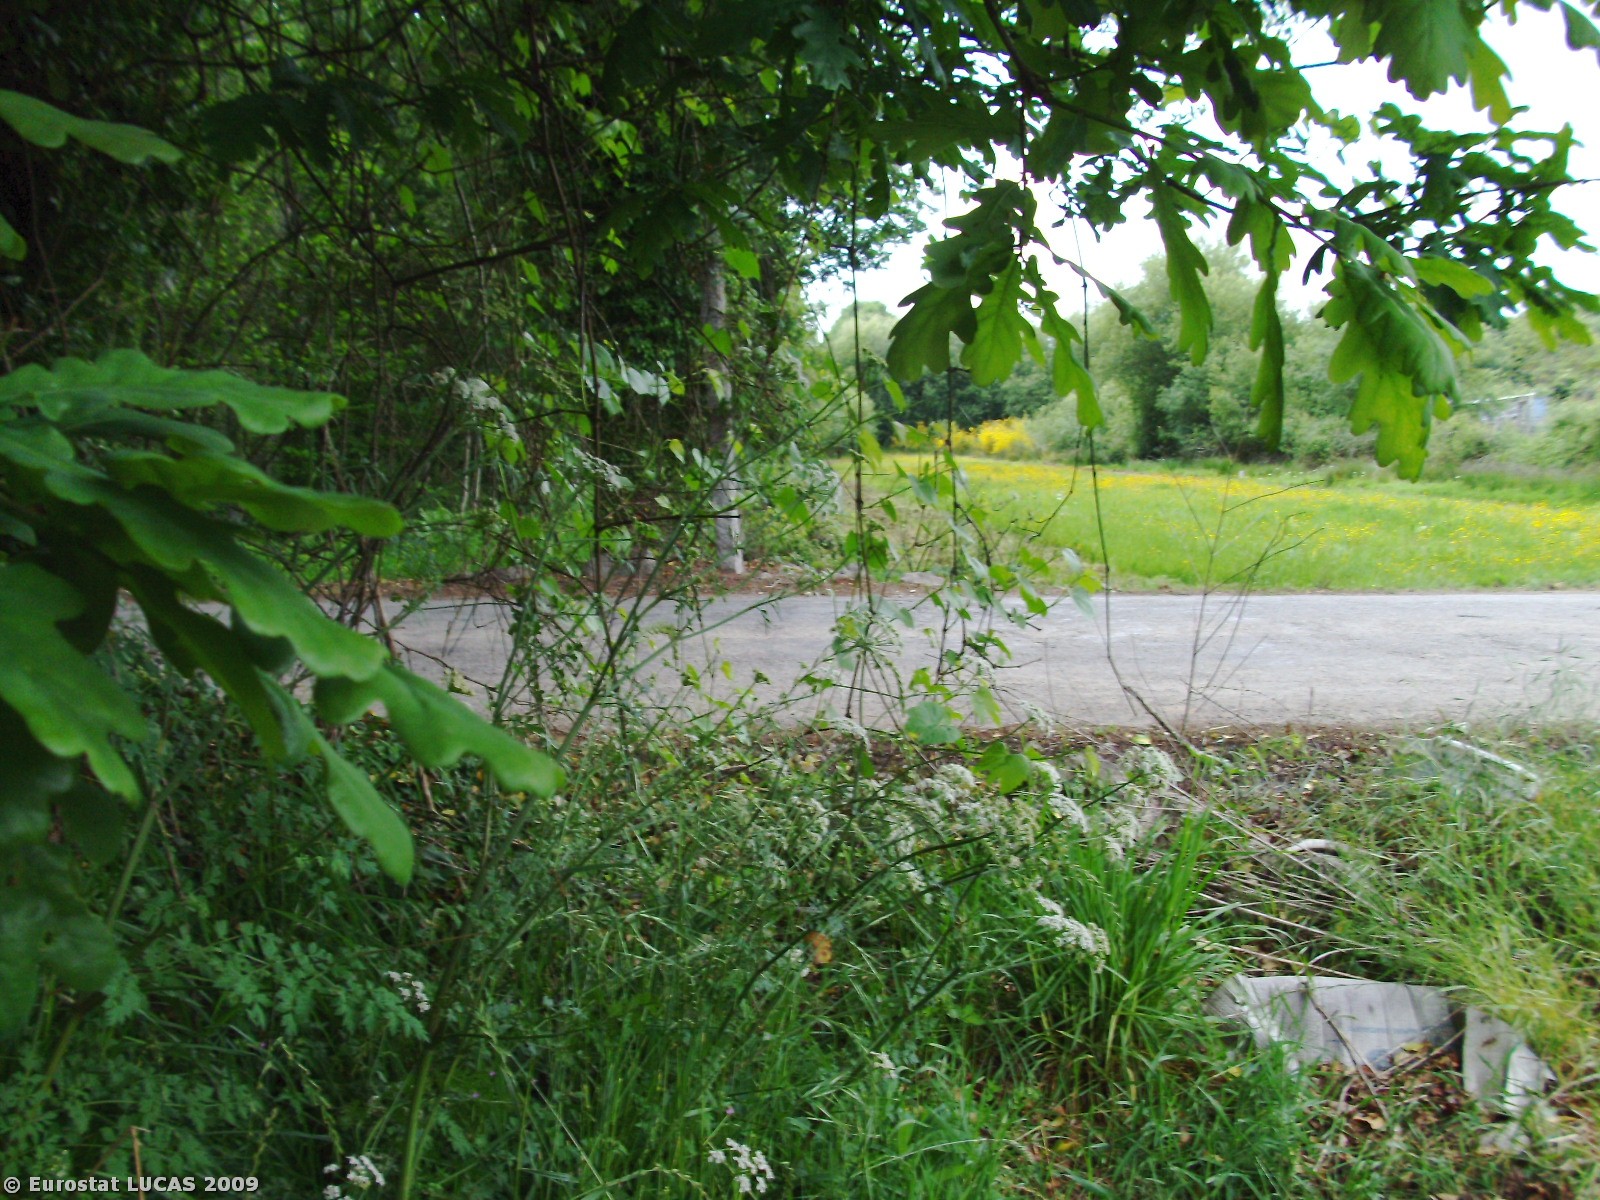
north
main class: Grassland
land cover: Spontaneously vegetated surfaces
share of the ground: > 75 %
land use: Fallow land
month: May
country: PT
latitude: 40.9855
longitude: -8.5105
